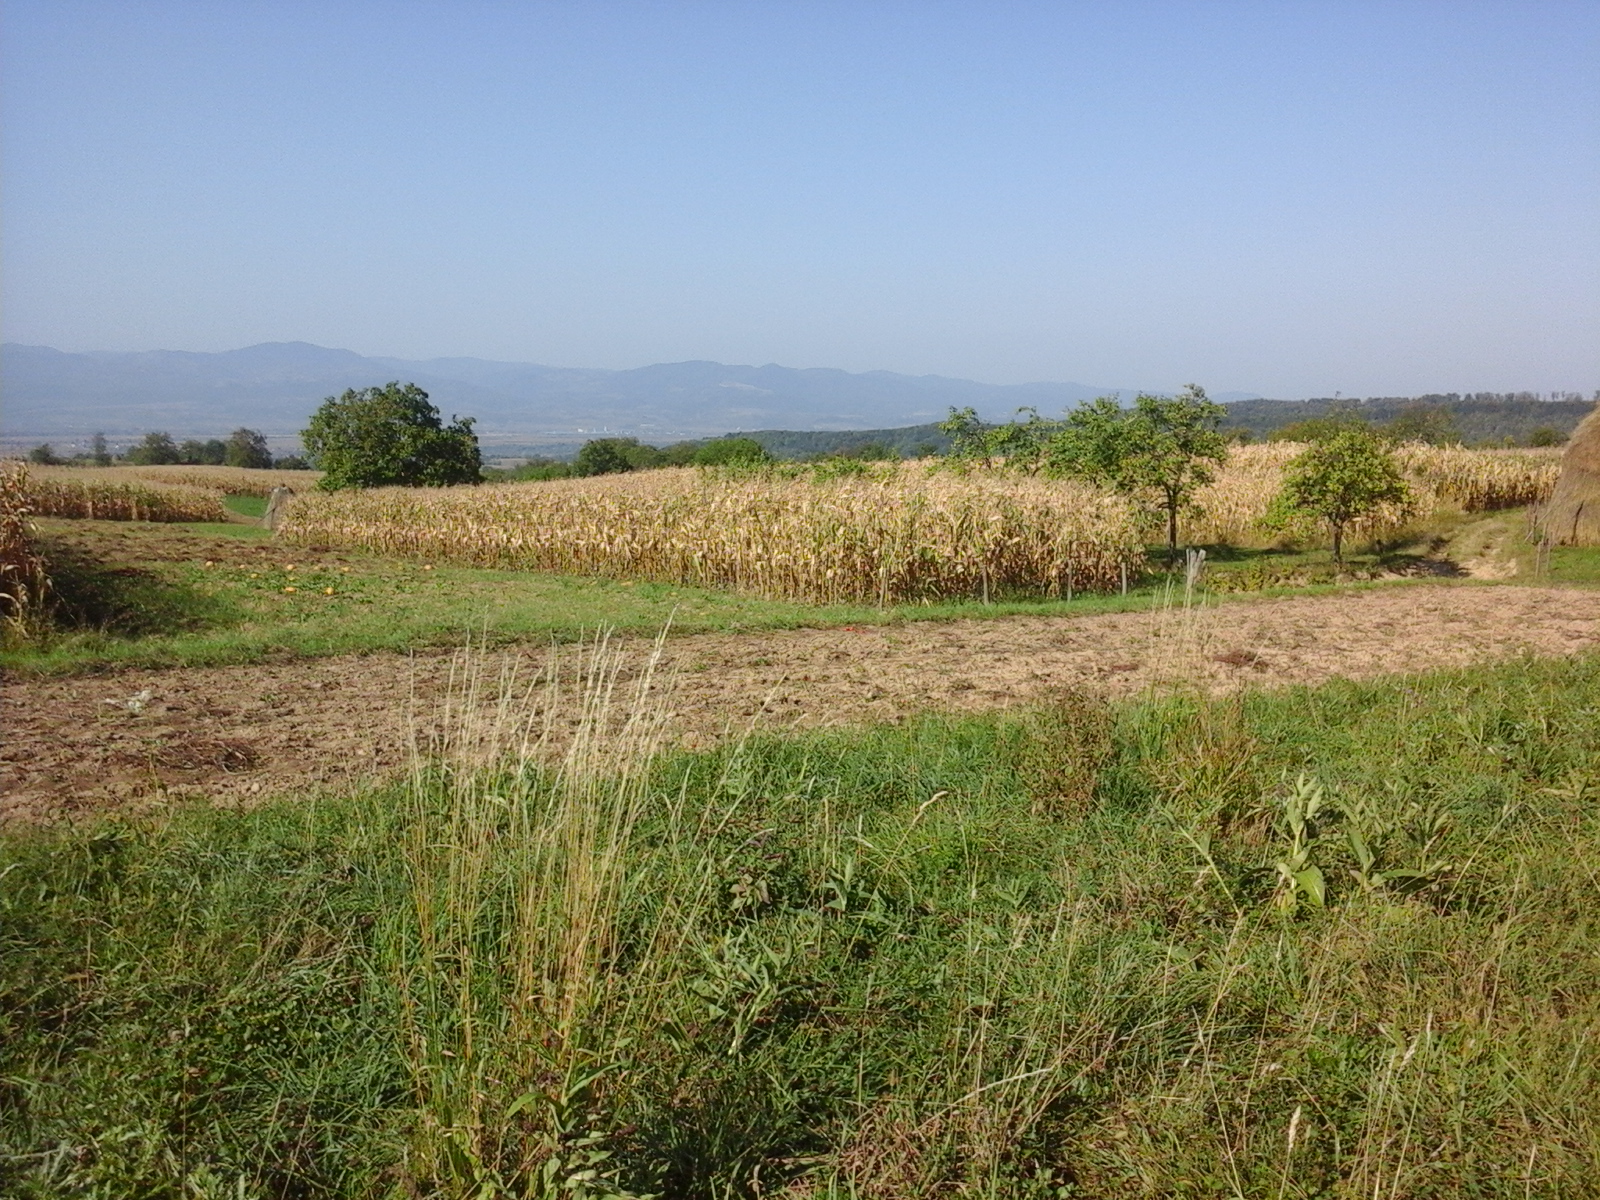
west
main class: Grassland
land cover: Grassland without tree/shrub cover
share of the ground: > 75 %
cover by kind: herbaceous plants 100 %
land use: Agriculture (excluding fallow land and kitchen gardens)
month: September
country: RO
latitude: 46.6316
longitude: 22.5266
